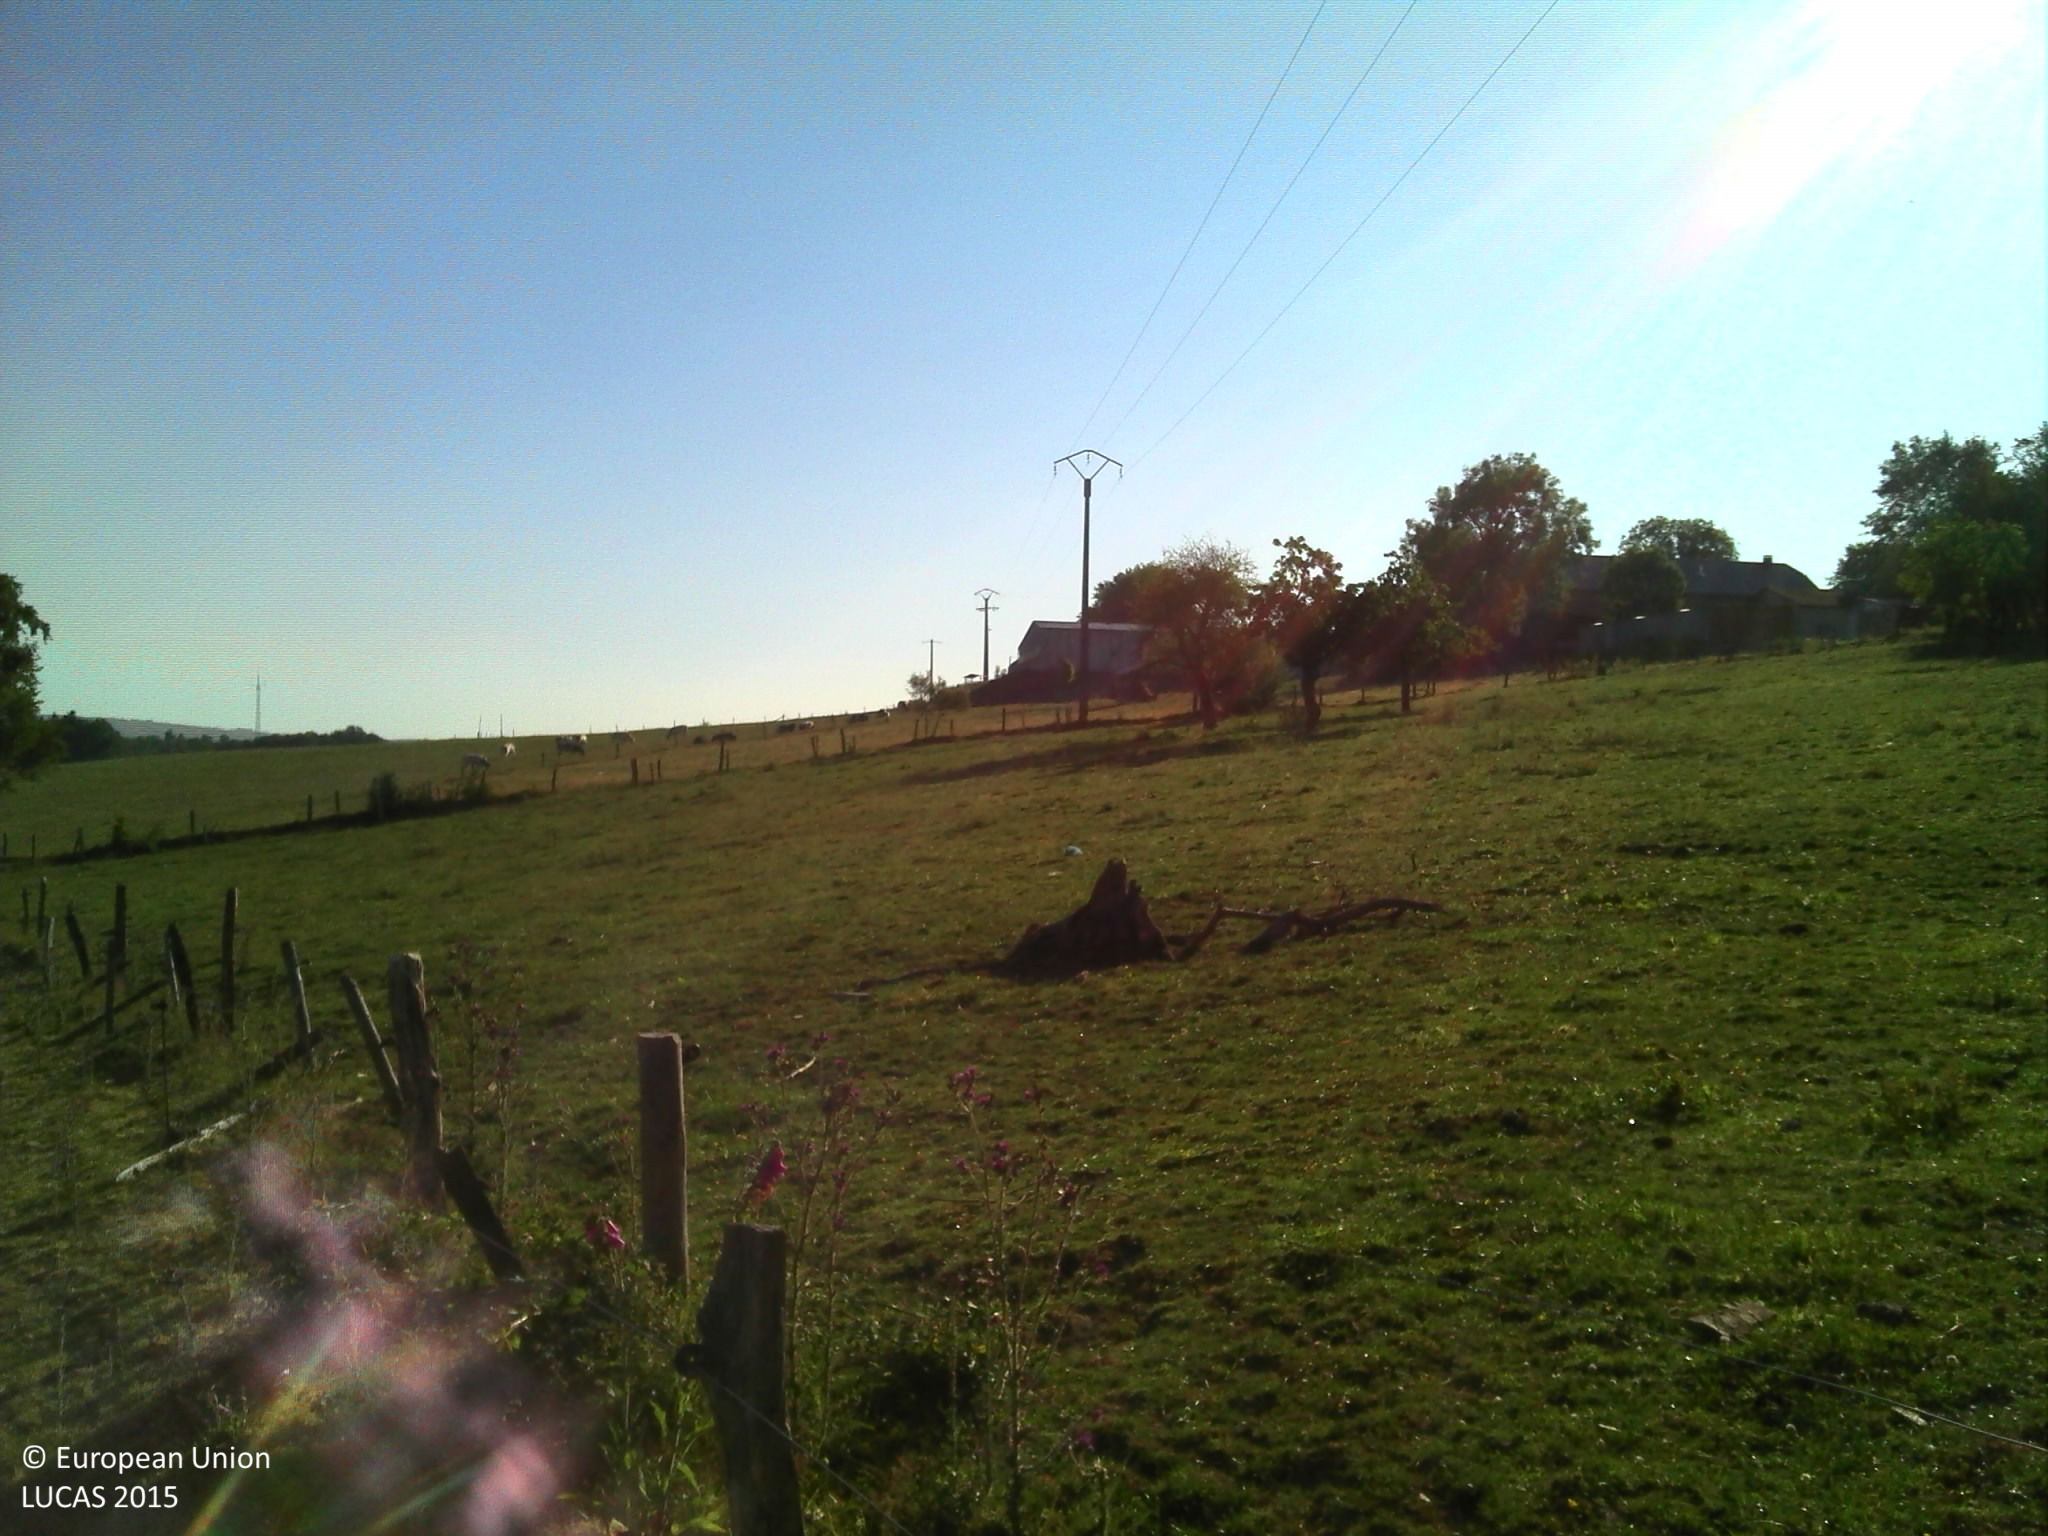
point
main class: Grassland
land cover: Grassland without tree/shrub cover
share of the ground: > 75 %
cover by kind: herbaceous plants 100 %
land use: Agriculture (excluding fallow land and kitchen gardens)
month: July
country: BE
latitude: 50.1372
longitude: 5.6473
